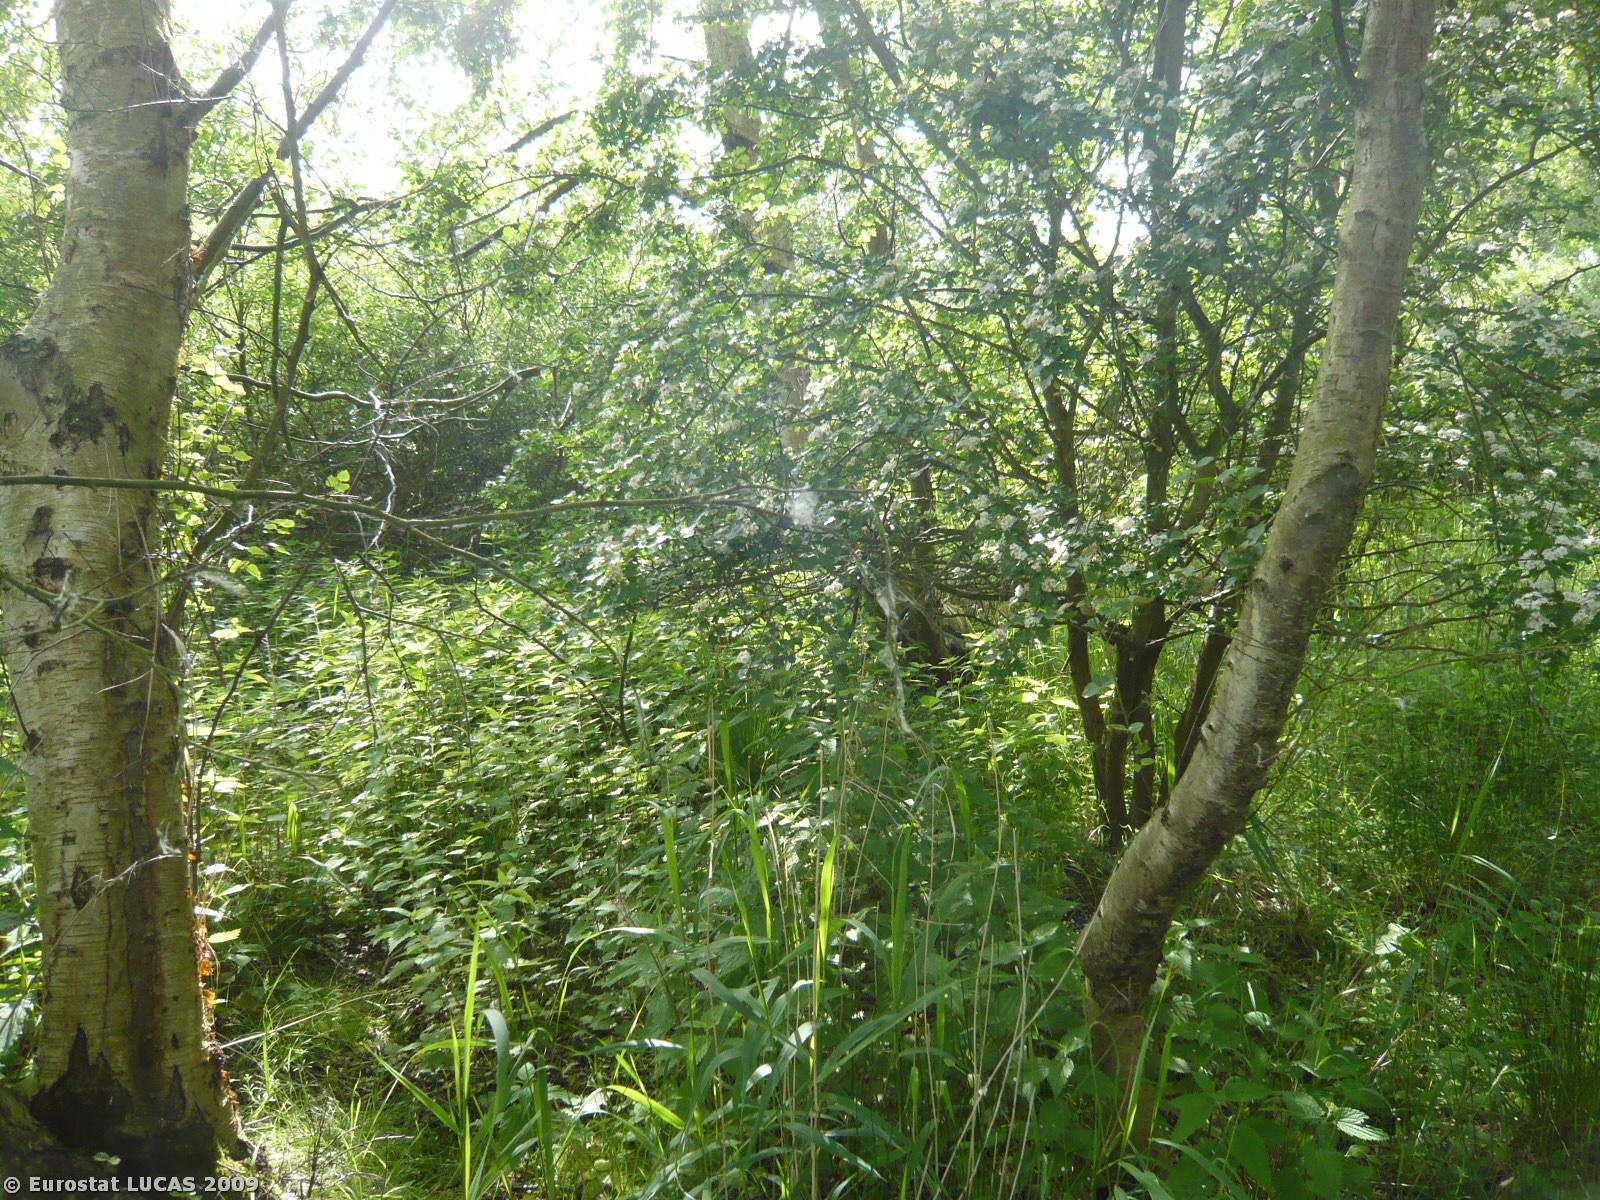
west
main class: Woodland
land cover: Broadleaved woodland
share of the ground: > 75 %
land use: Unused
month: June
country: DK
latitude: 54.5905
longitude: 11.9643
